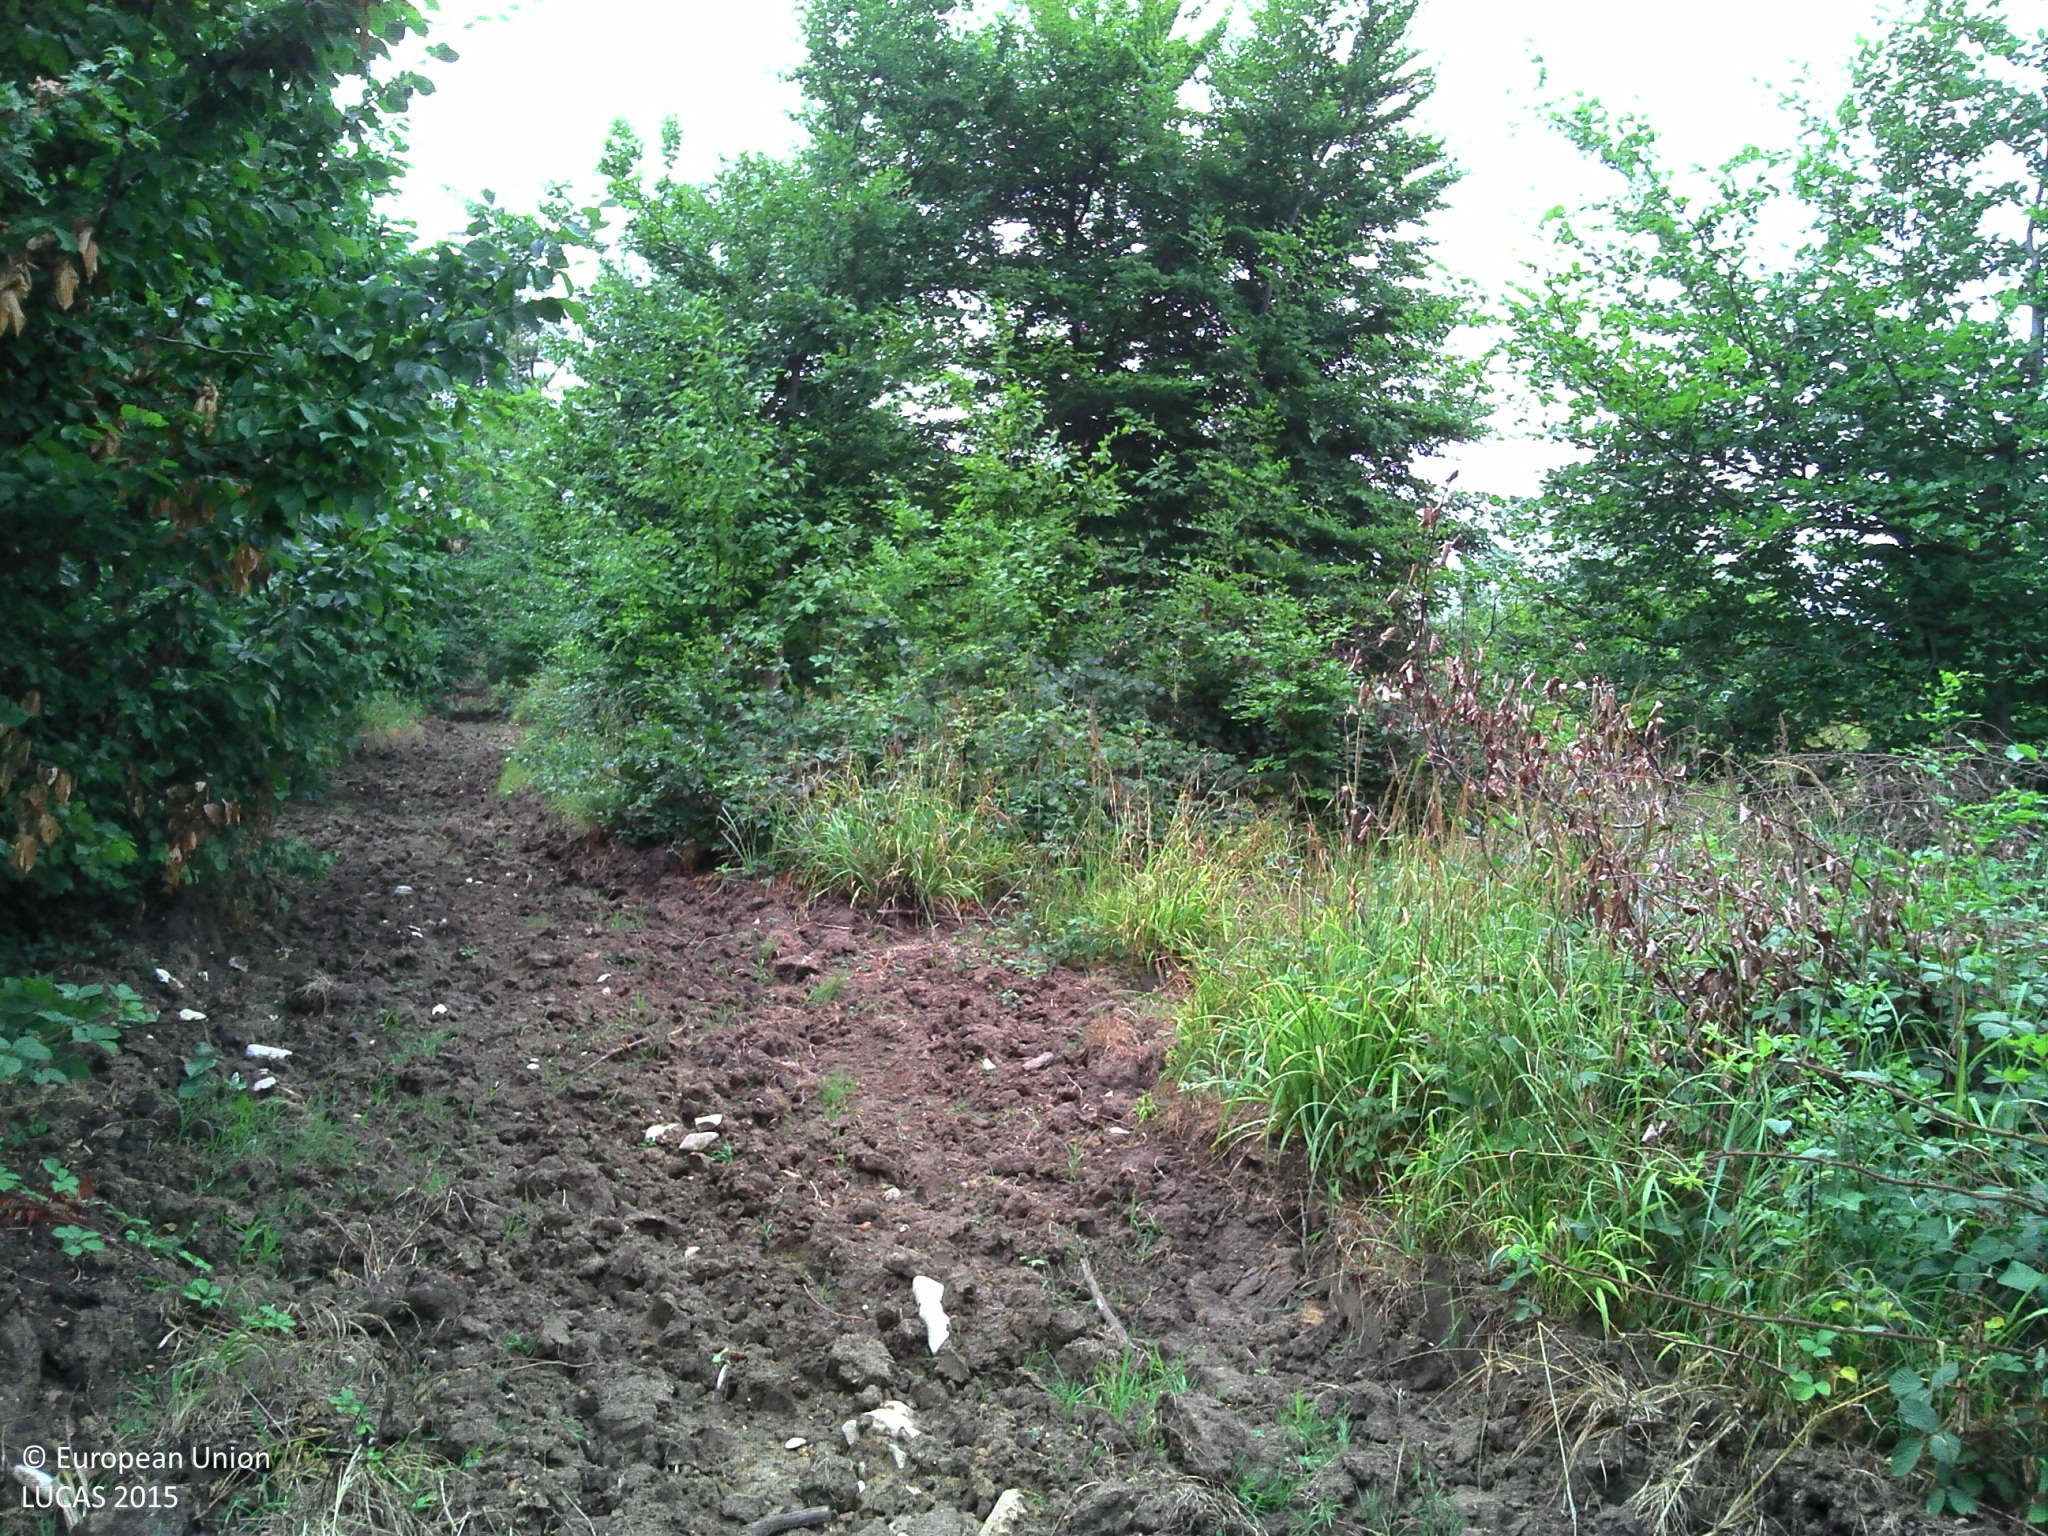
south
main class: Woodland
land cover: Broadleaved woodland
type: acidophilous oak and oak-birch forest
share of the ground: > 75 %
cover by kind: broadleaved forest trees 80 %, shrubs 15 %, herbaceous plants 5 %
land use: Forestry
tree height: > 5 m
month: July
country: FR
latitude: 49.2365
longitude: 2.5584
